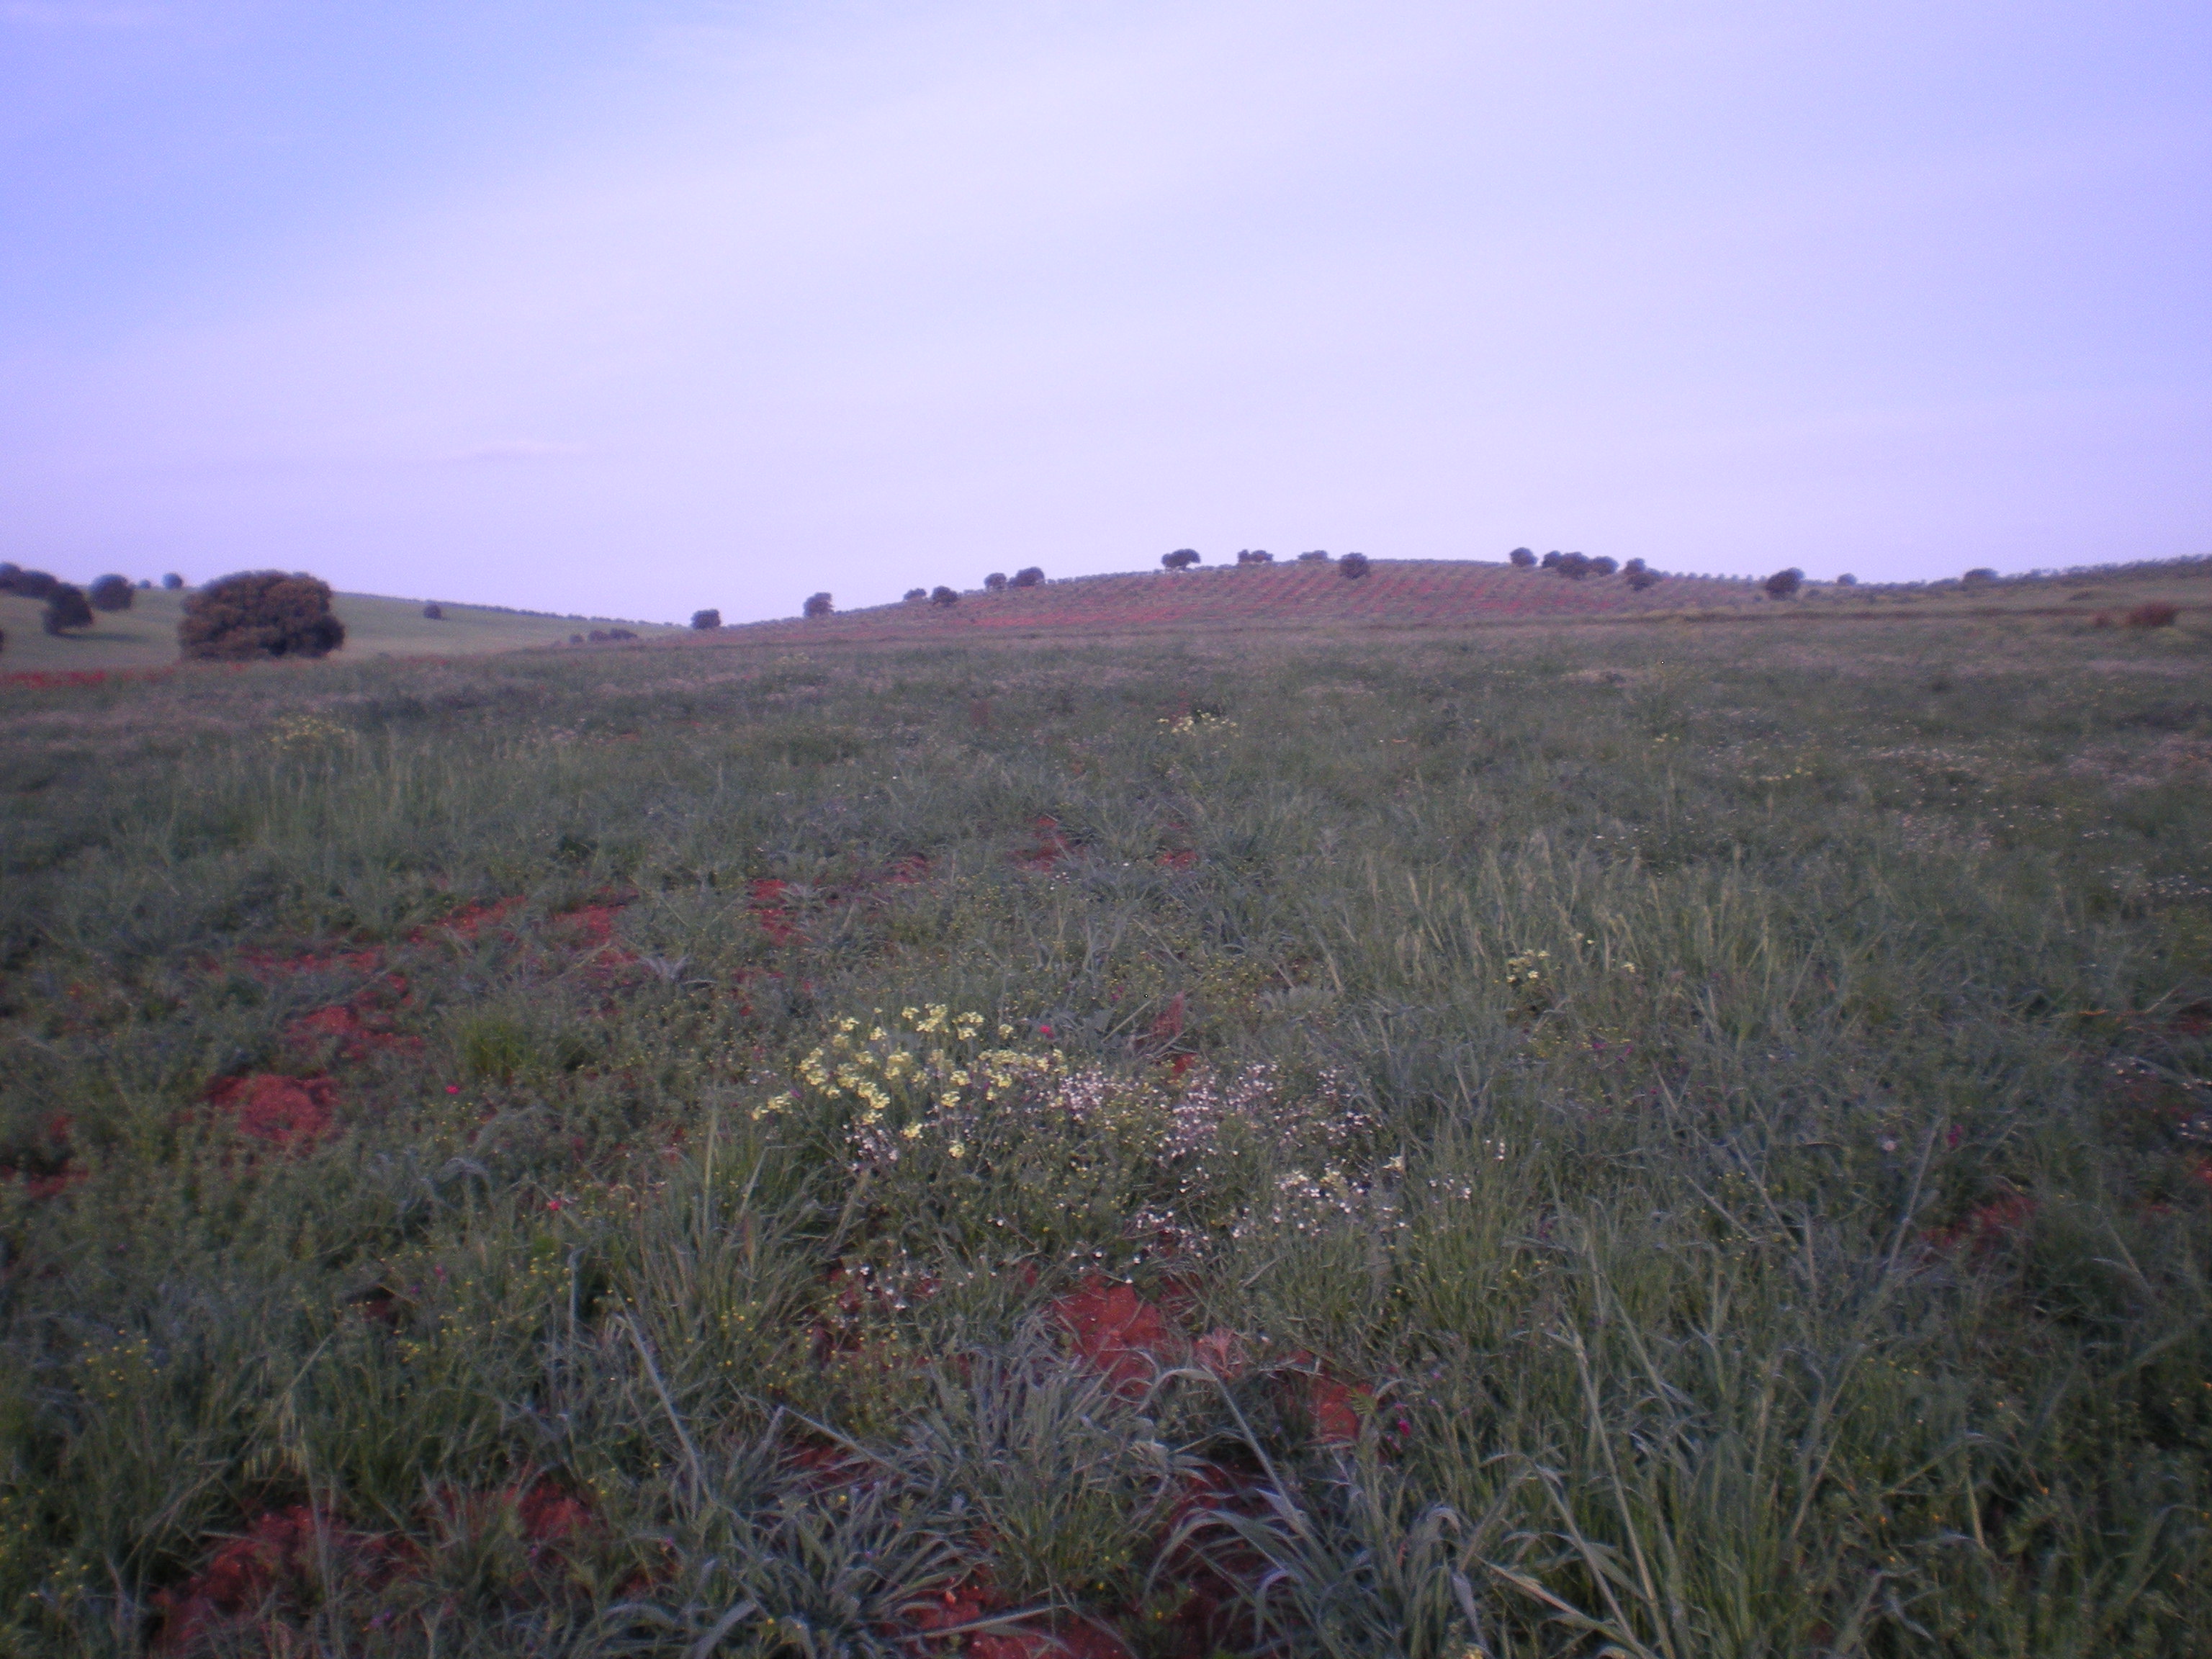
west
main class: Grassland
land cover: Spontaneously vegetated surfaces
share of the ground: > 75 %
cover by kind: herbaceous plants 95 %, unconsolidated bare surface 5 %
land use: Fallow land
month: April
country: ES
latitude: 38.7599
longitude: -3.5111
